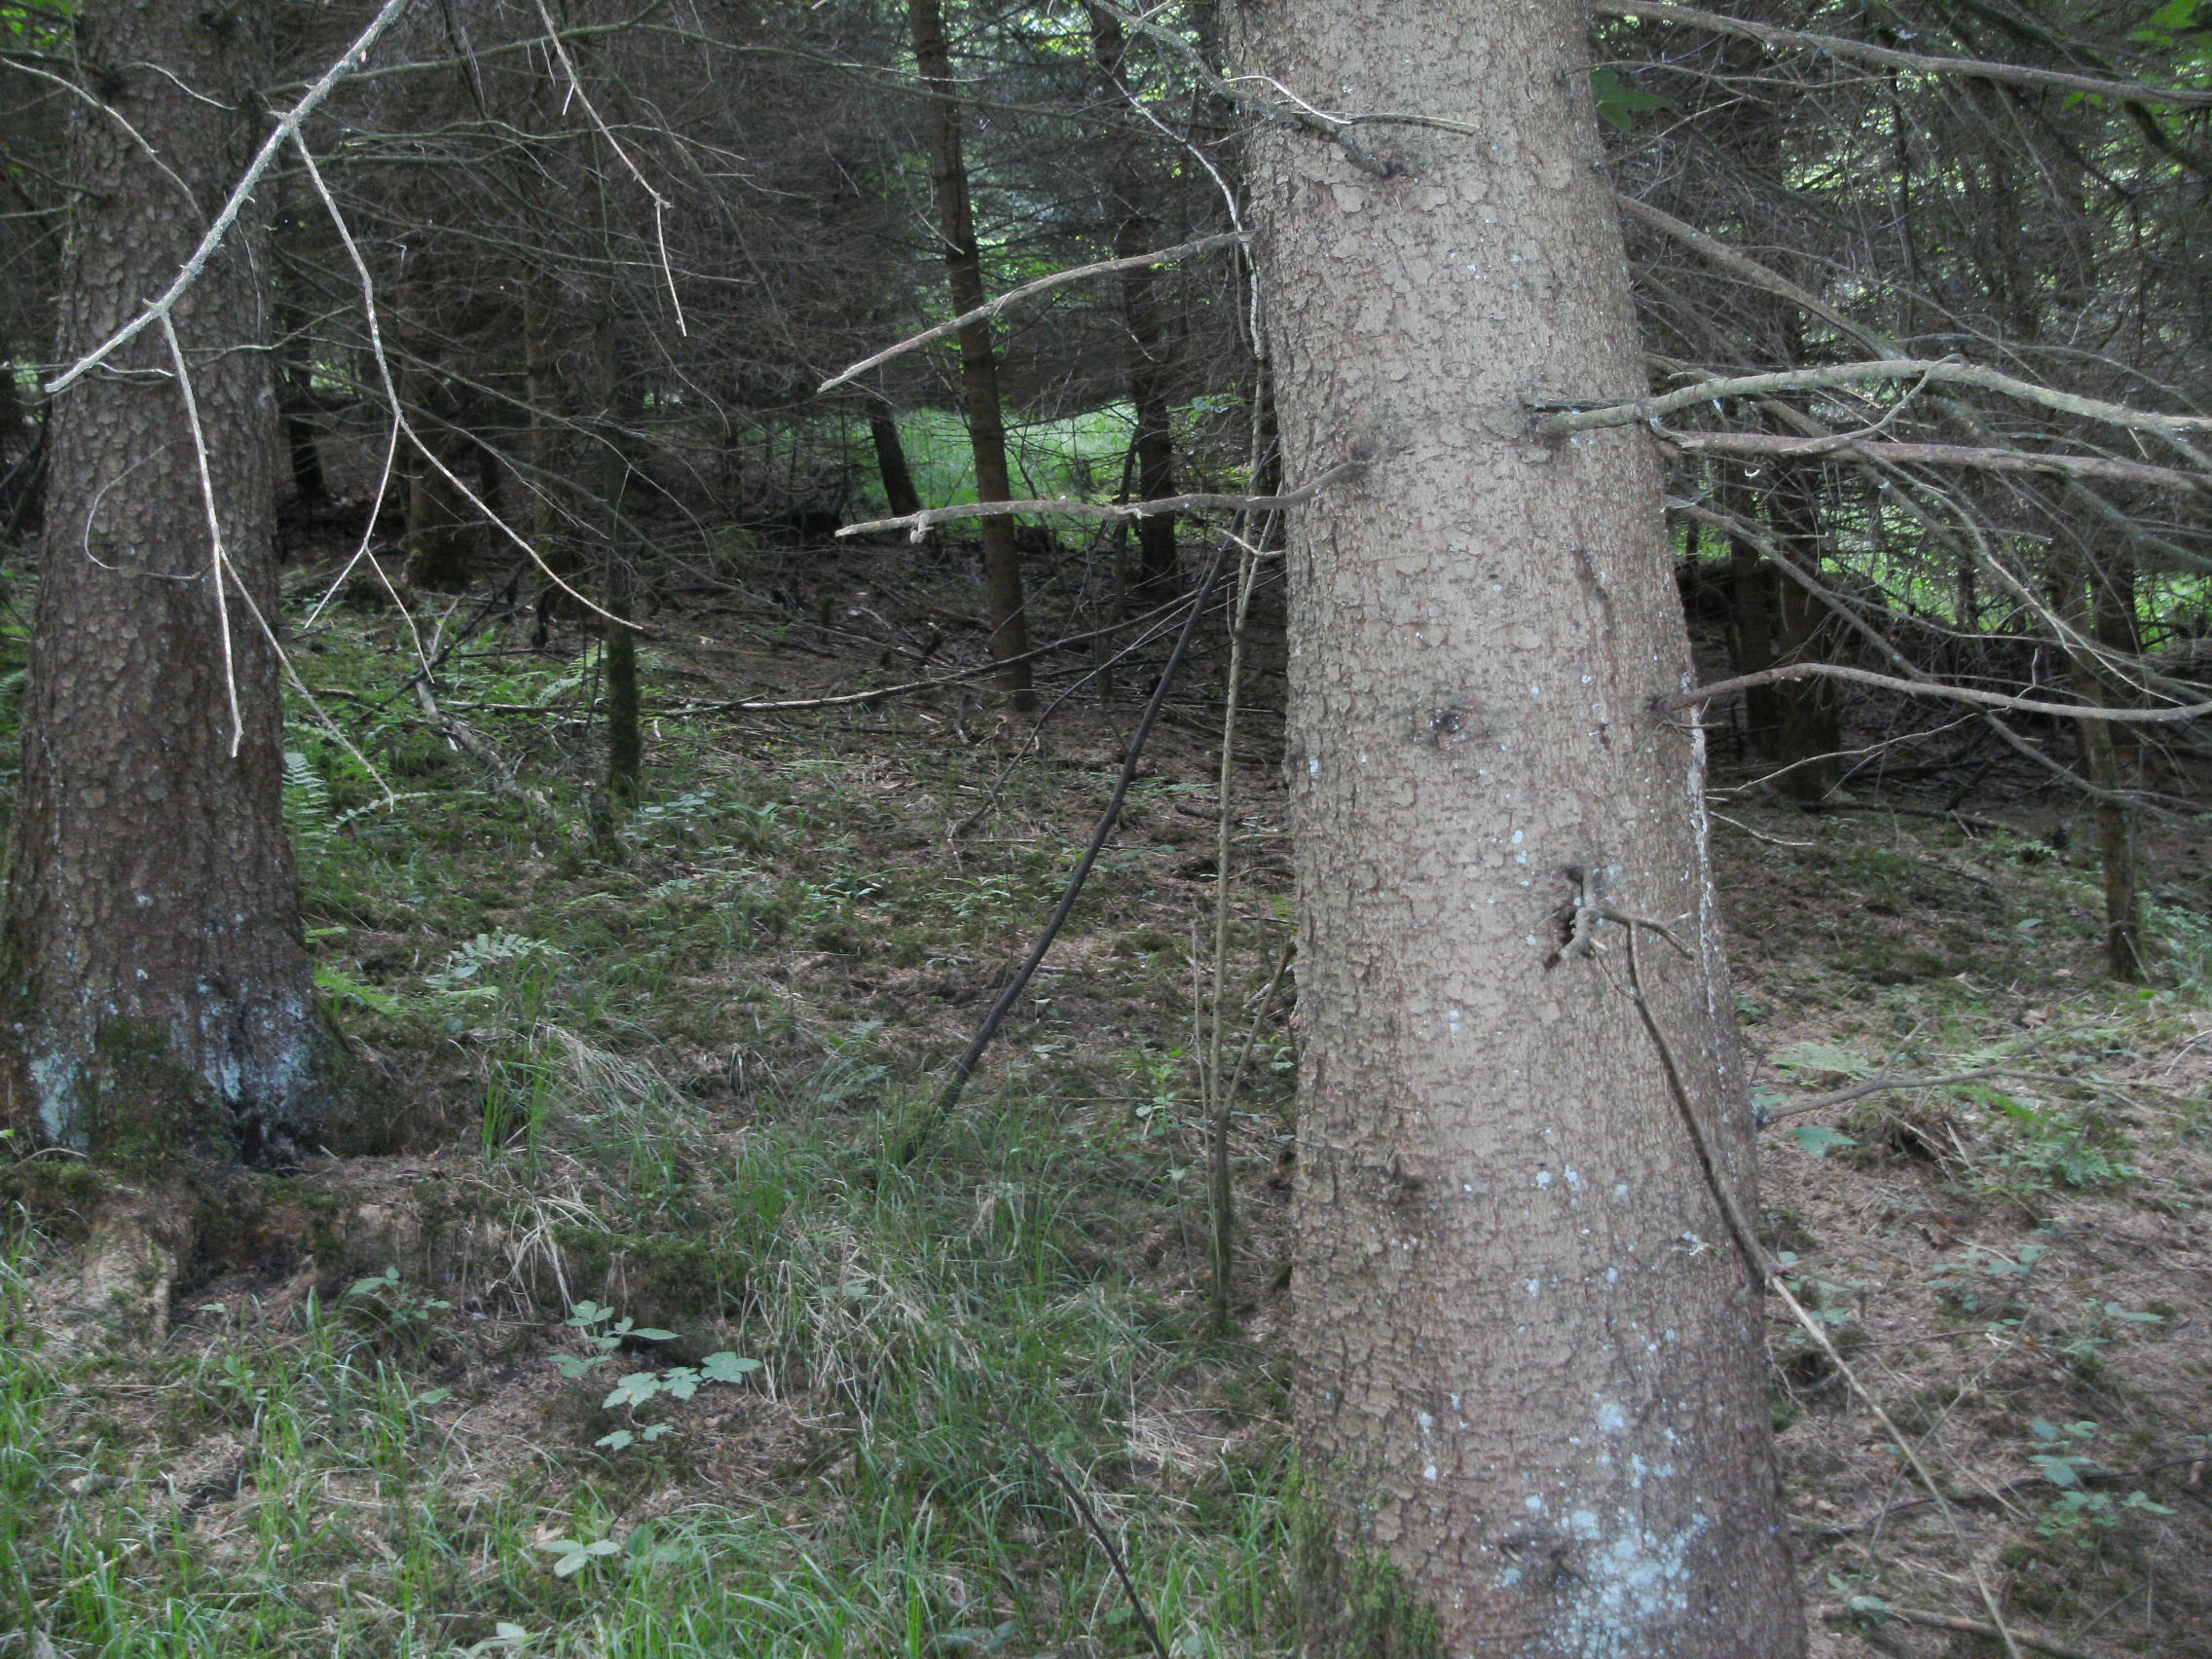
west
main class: Woodland
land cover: Spruce dominated coniferous woodland
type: hemiboreal forest and nemoral coniferous forest and mixed broadleaved-coniferous forest
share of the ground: > 75 %
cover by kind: coniferous forest trees 95 %, herbaceous plants 5 %
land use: Forestry
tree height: > 5 m
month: May
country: AT
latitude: 48.4841
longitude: 13.7474
